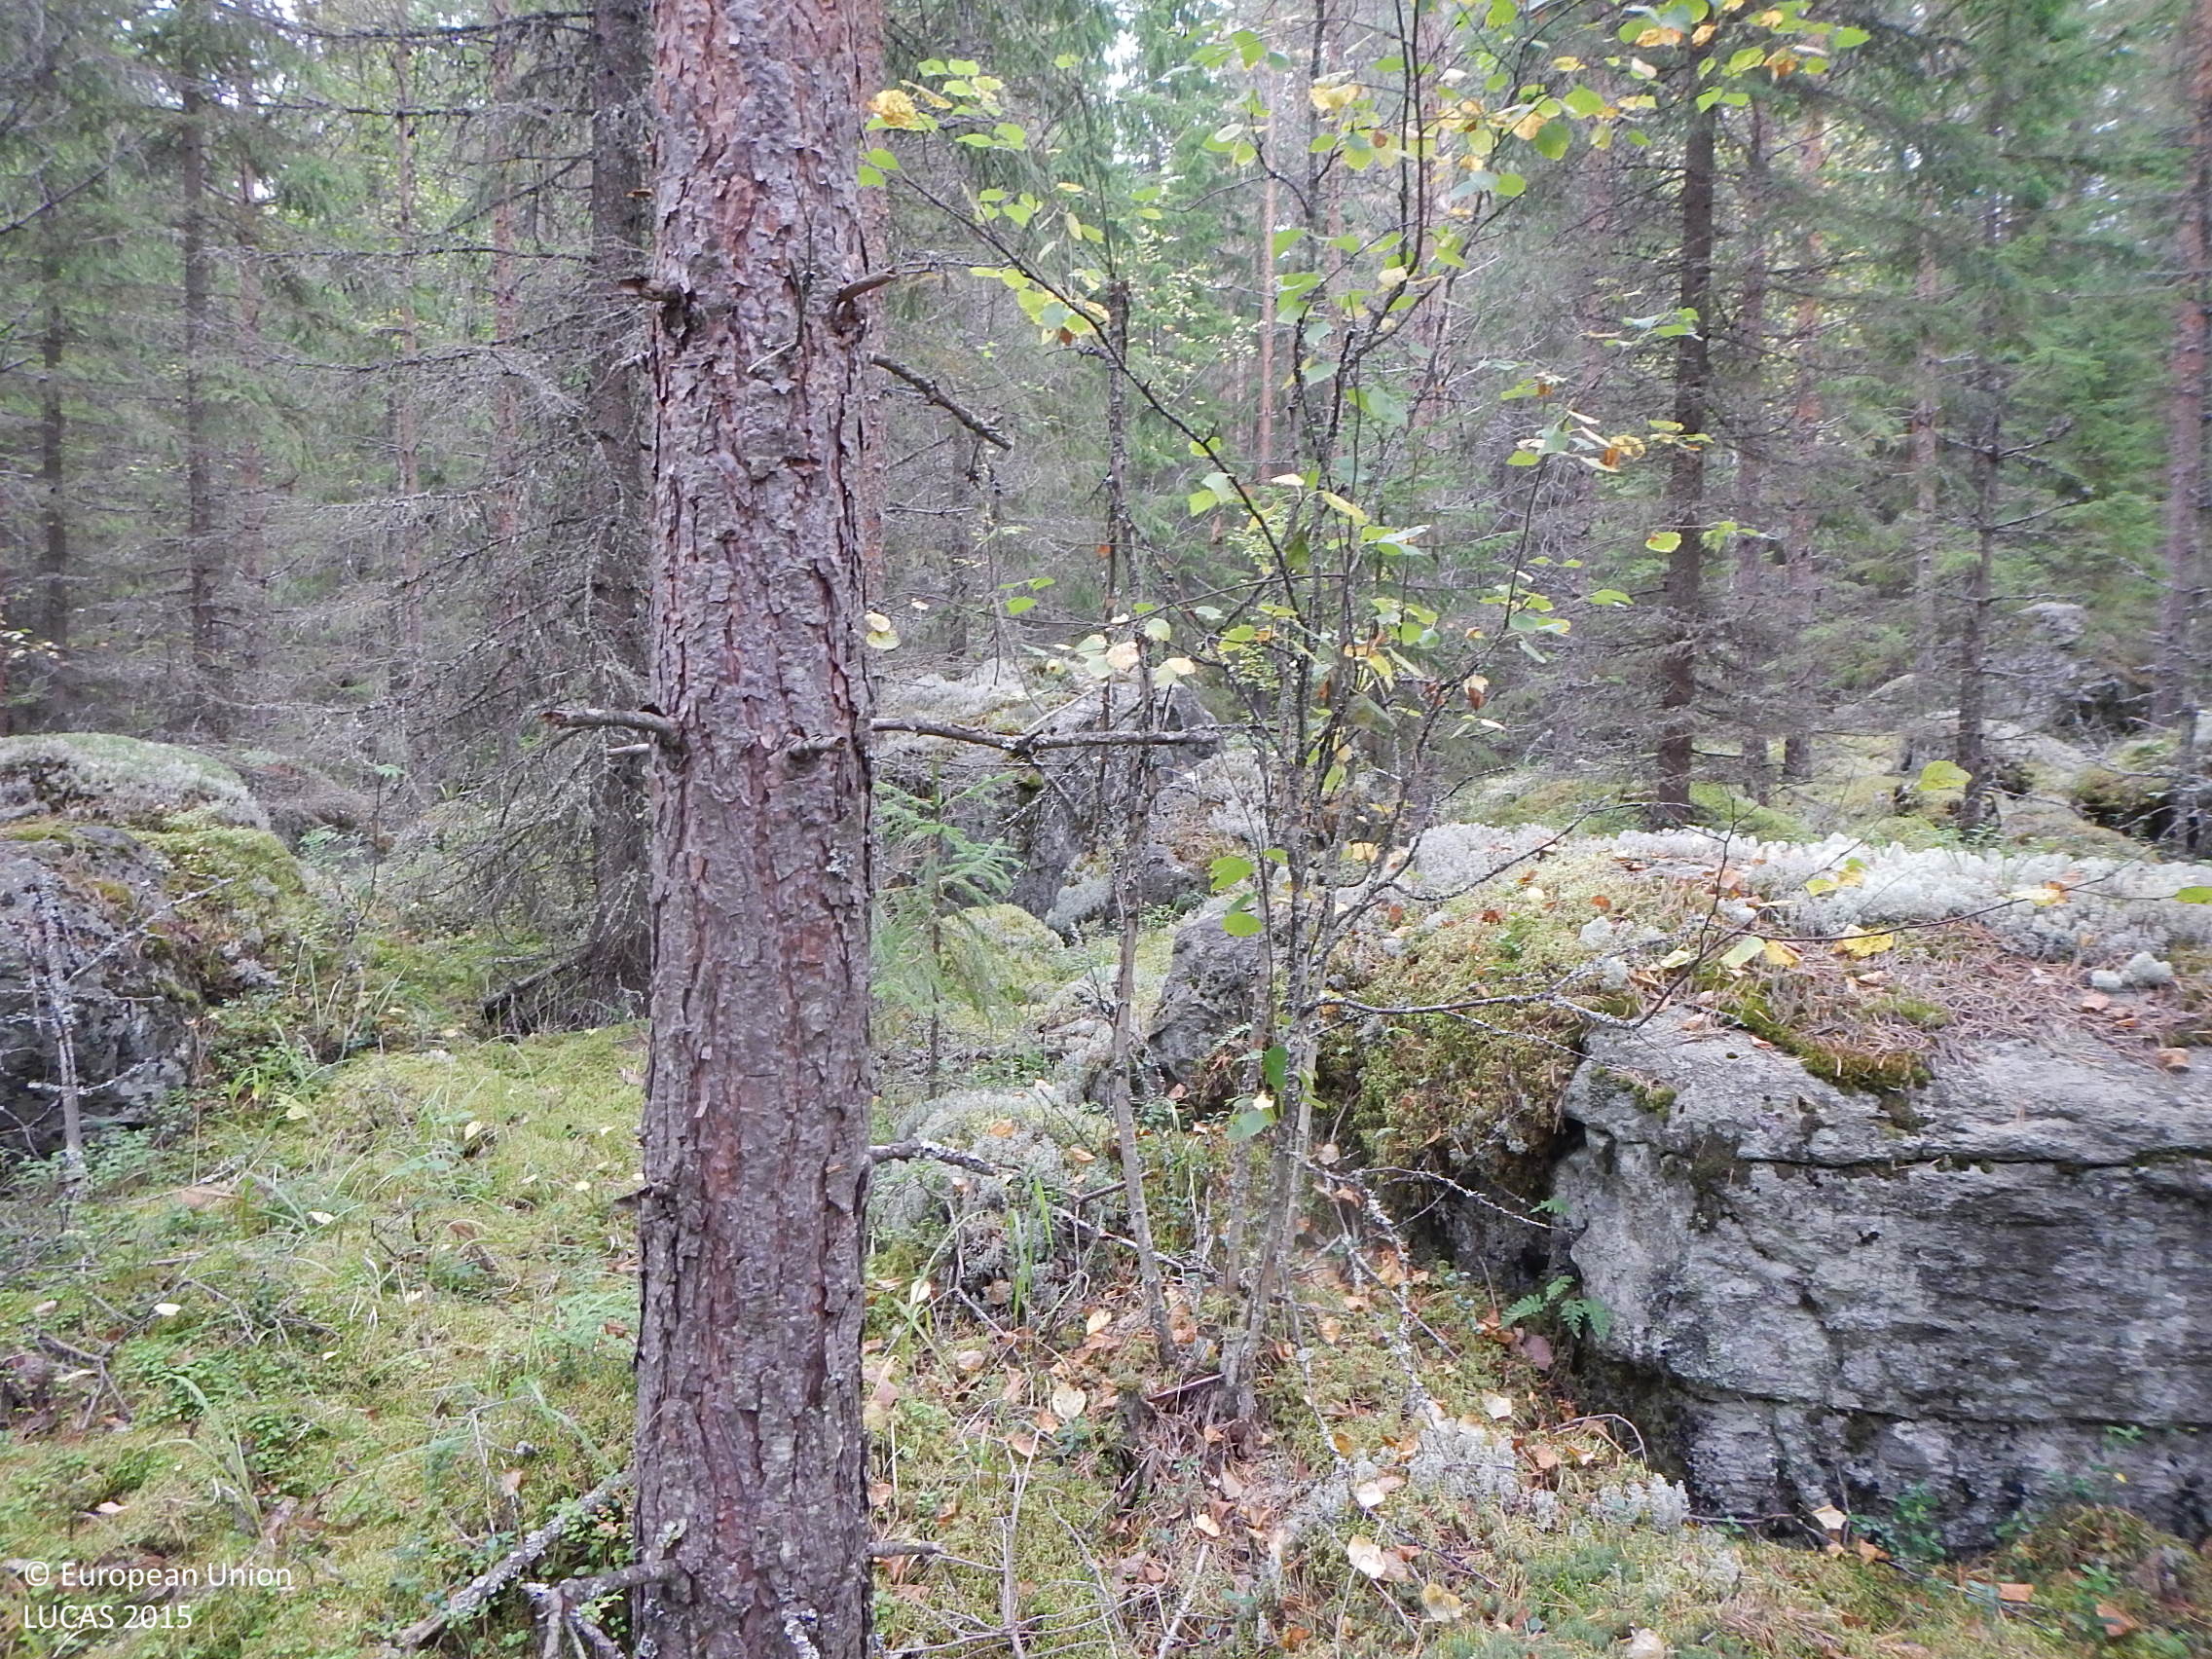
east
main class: Woodland
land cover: Pine dominated coniferous woodland
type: boreal forest
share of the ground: > 75 %
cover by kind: coniferous forest trees 80 %, lichens and mosses 15 %, shrubs 5 %
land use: Forestry
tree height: > 5 m
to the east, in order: Pine dominated coniferous woodland; Other coniferous woodland; Spruce dominated coniferous woodland; Spruce dominated mixed woodland
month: September
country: FI
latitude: 61.5811
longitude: 22.0169
